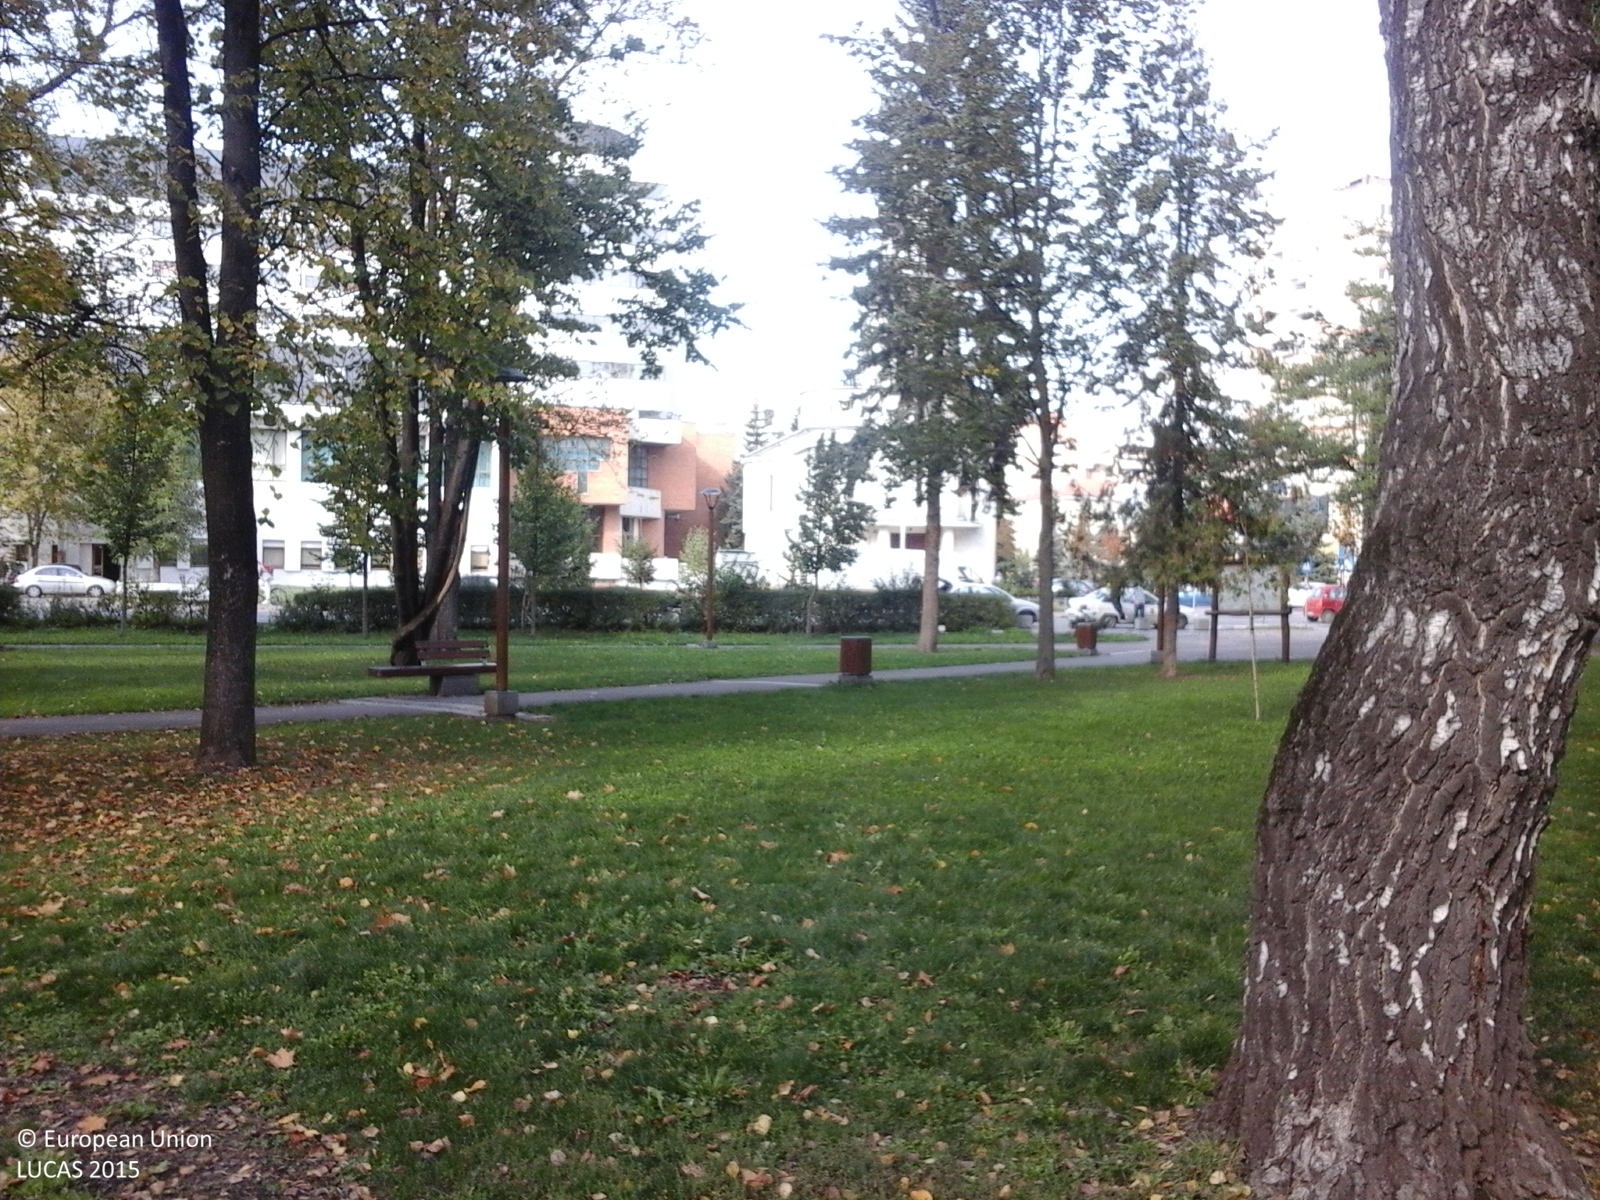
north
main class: Woodland
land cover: Broadleaved woodland
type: beech forest
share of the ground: > 75 %
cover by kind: broadleaved forest trees 80 %, herbaceous plants 20 %
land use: Amenities, museums, leisure
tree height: > 5 m
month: October
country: RO
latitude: 46.3592
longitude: 25.8021
